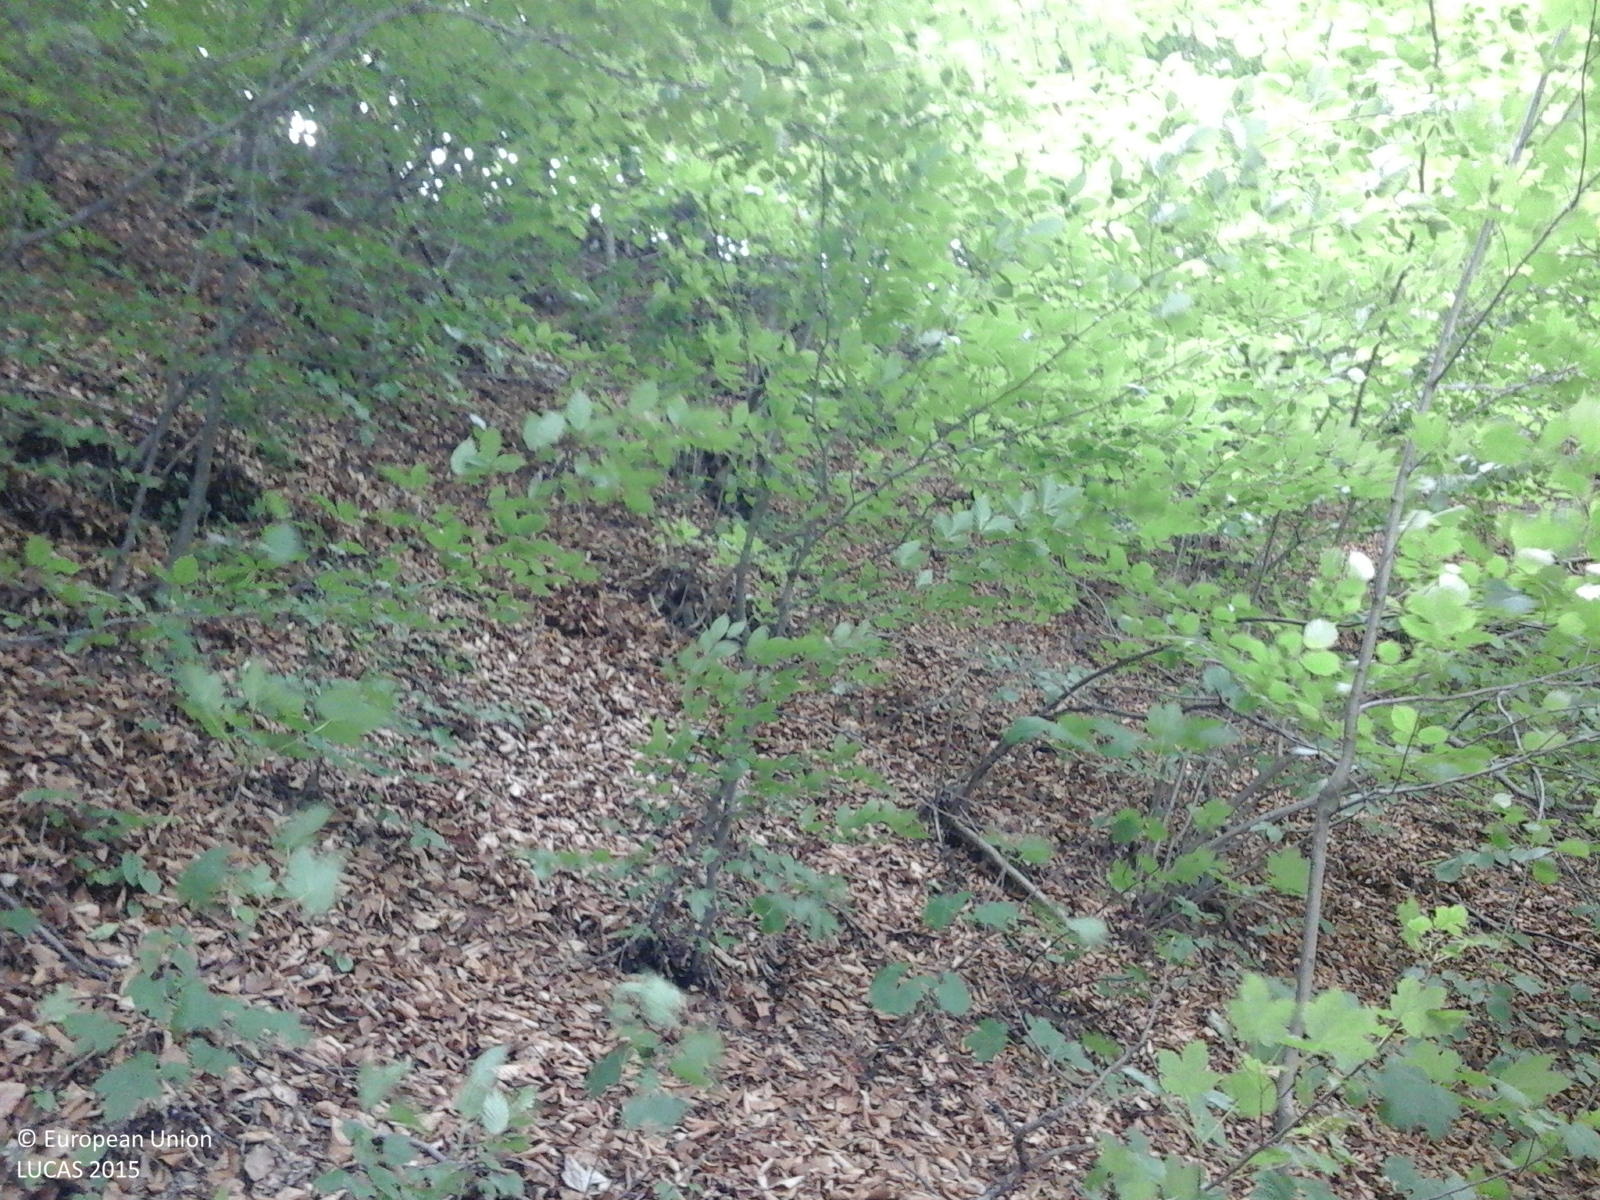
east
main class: Woodland
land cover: Broadleaved woodland
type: beech forest
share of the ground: > 75 %
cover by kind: broadleaved forest trees 100 %
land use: Forestry
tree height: > 5 m
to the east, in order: Broadleaved woodland; Fences; Grassland without tree/shrub cover; Fences; Grass margins; Tracks; Grass margins; Artificial constructions in urban areas; Broadleaved woodland; Tracks; Inland fresh running water; Spruce dominated coniferous woodland
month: May
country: RO
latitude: 45.3895
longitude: 25.5431
